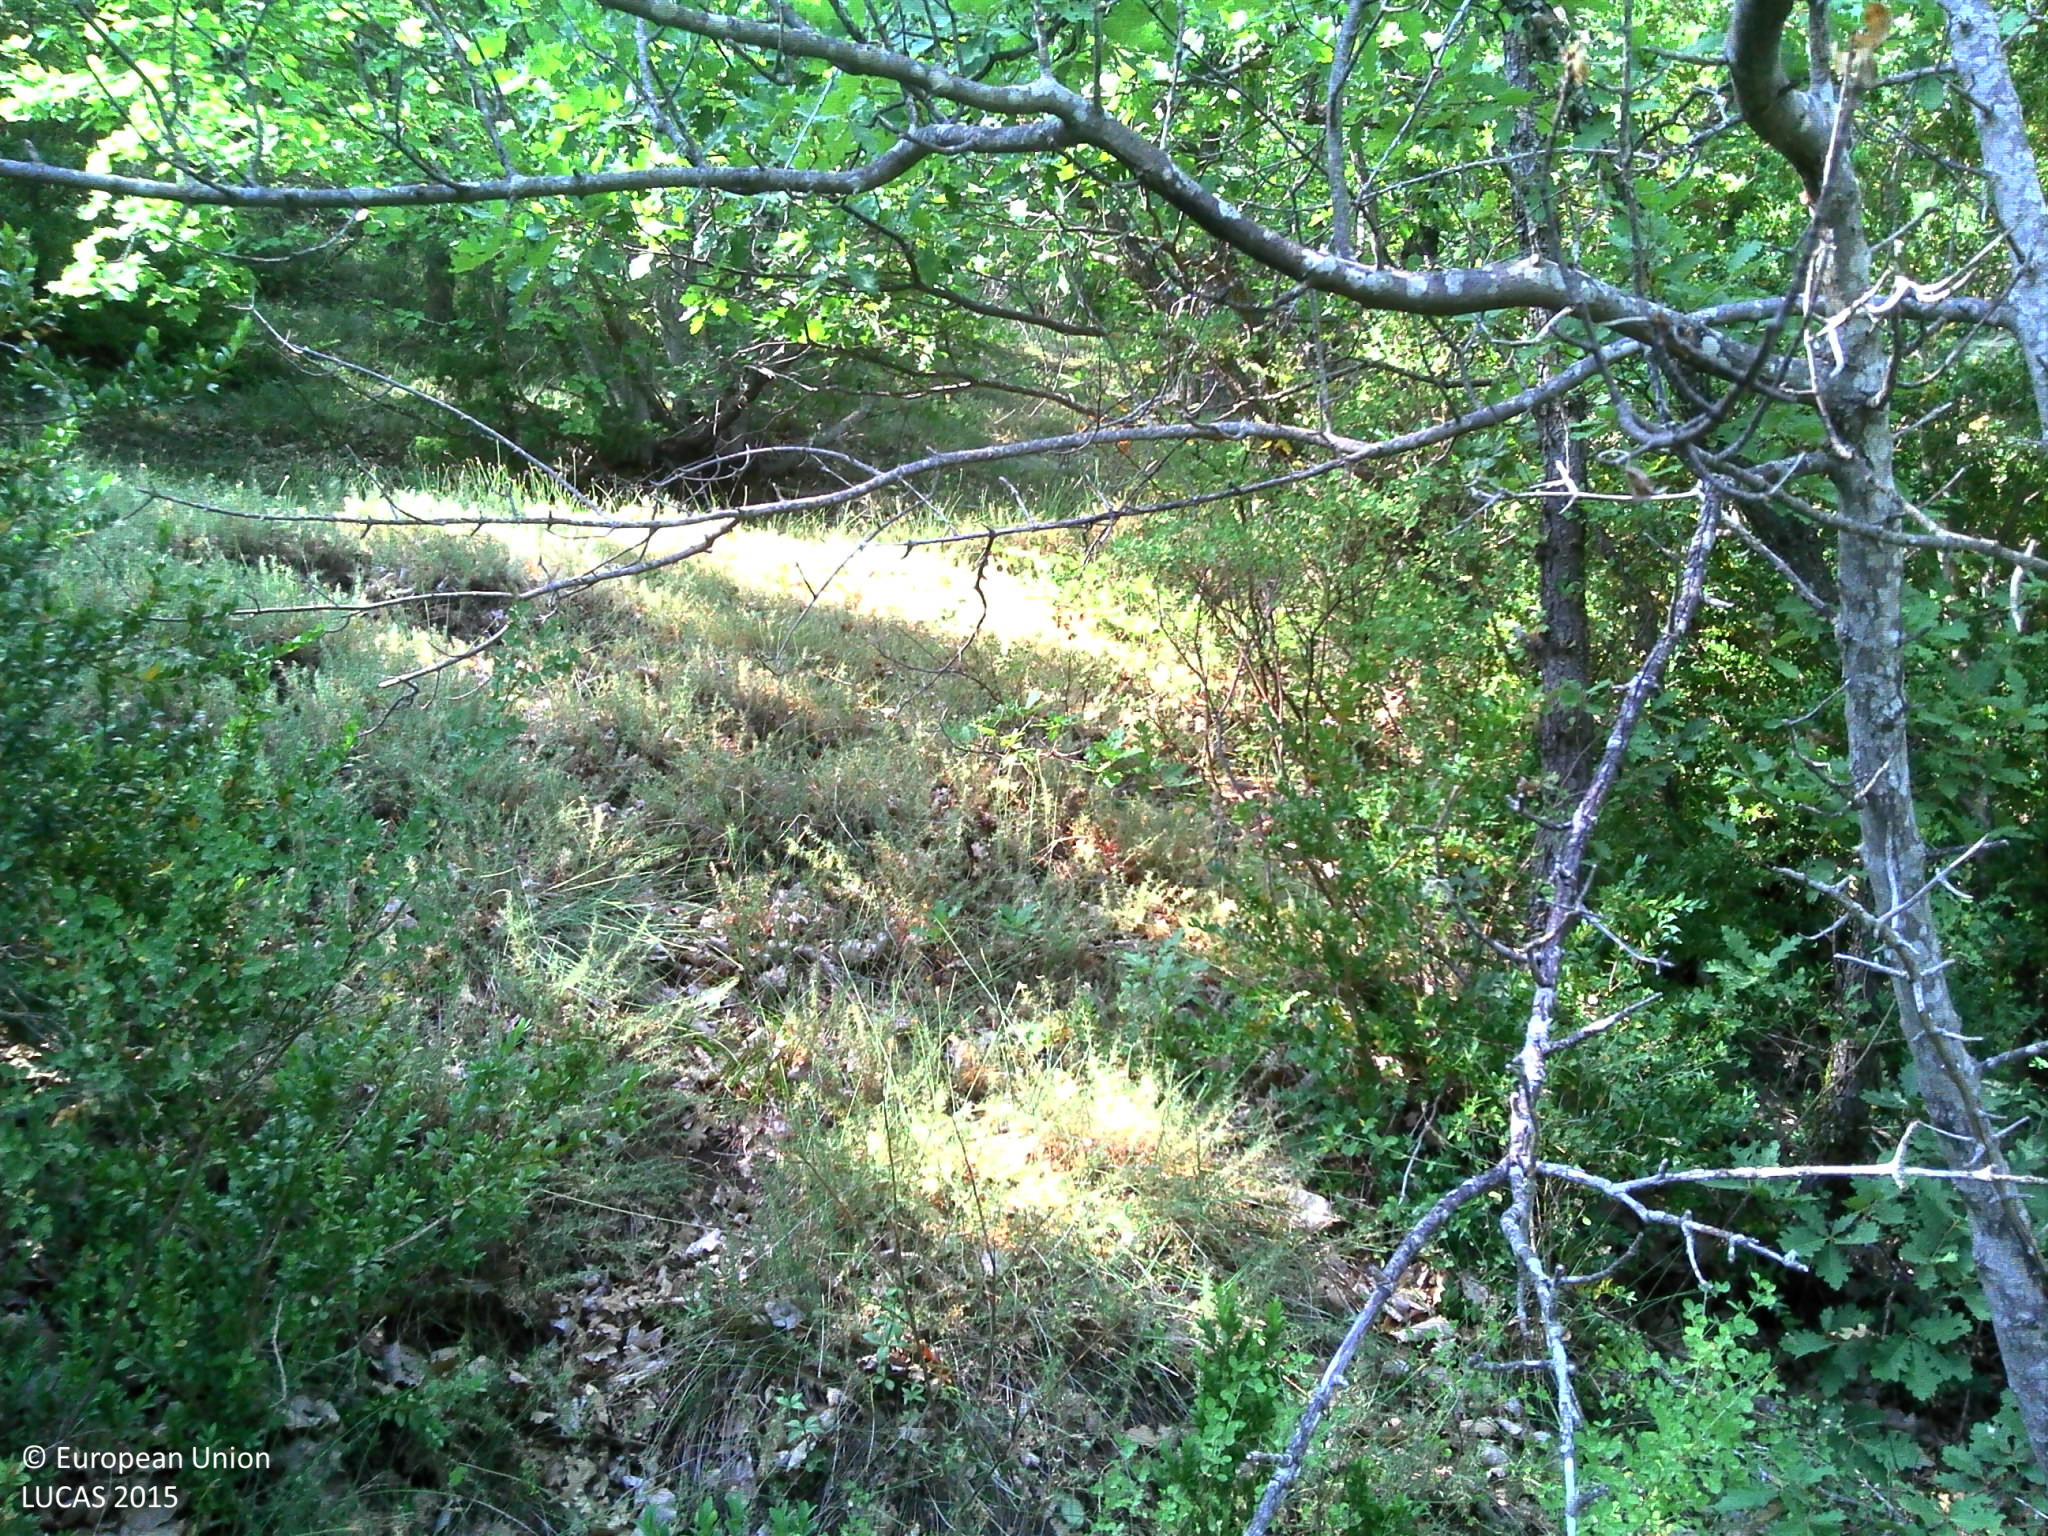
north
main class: Woodland
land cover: Broadleaved woodland
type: acidophilous oak and oak-birch forest
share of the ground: > 75 %
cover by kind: broadleaved forest trees 40 %, shrubs 20 %, herbaceous plants 20 %, unconsolidated bare surface 10 %, coniferous forest trees 5 %, lichens and mosses 5 %
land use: Semi-natural and natural areas not in use
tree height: > 5 m
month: July
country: FR
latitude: 44.0320
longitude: 5.4040
